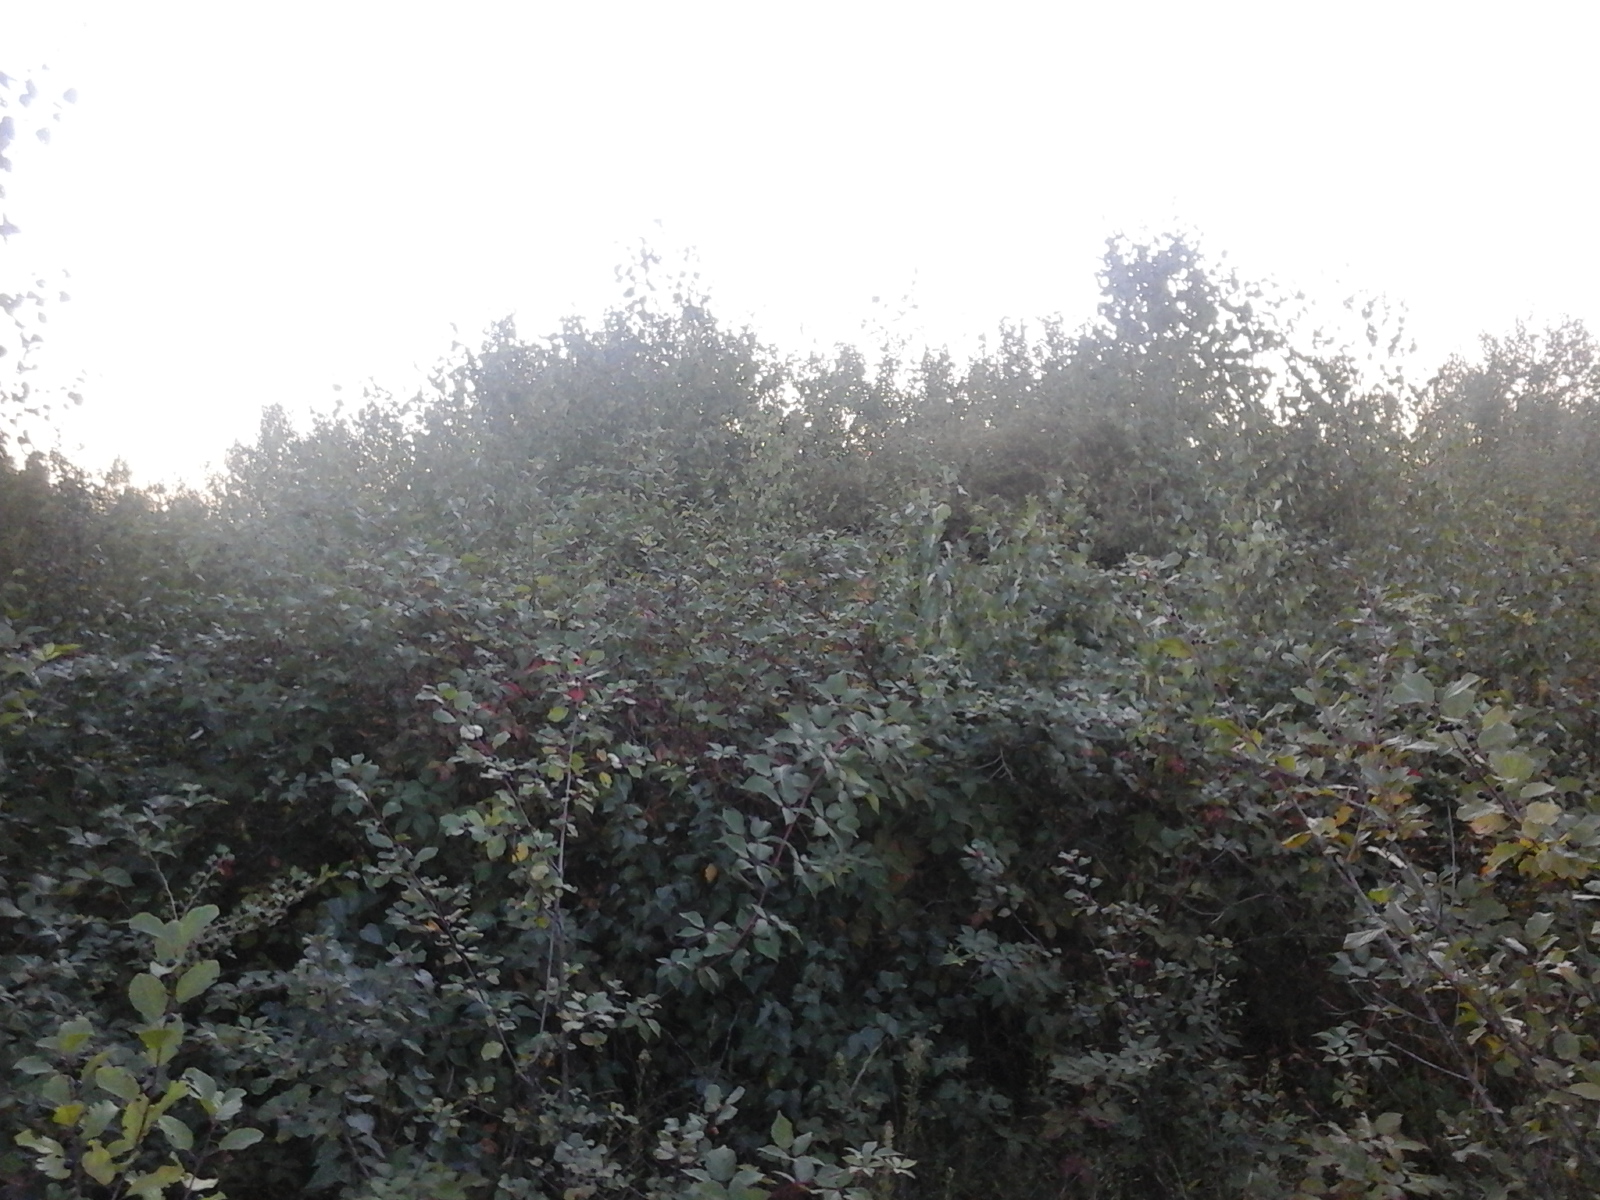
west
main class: Shrubland
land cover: Shrubland with sparse tree cover
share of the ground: > 75 %
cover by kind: shrubs 95 %, broadleaved forest trees 5 %
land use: Semi-natural and natural areas not in use
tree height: > 5 m
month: September
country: RO
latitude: 47.9066
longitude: 23.4402
